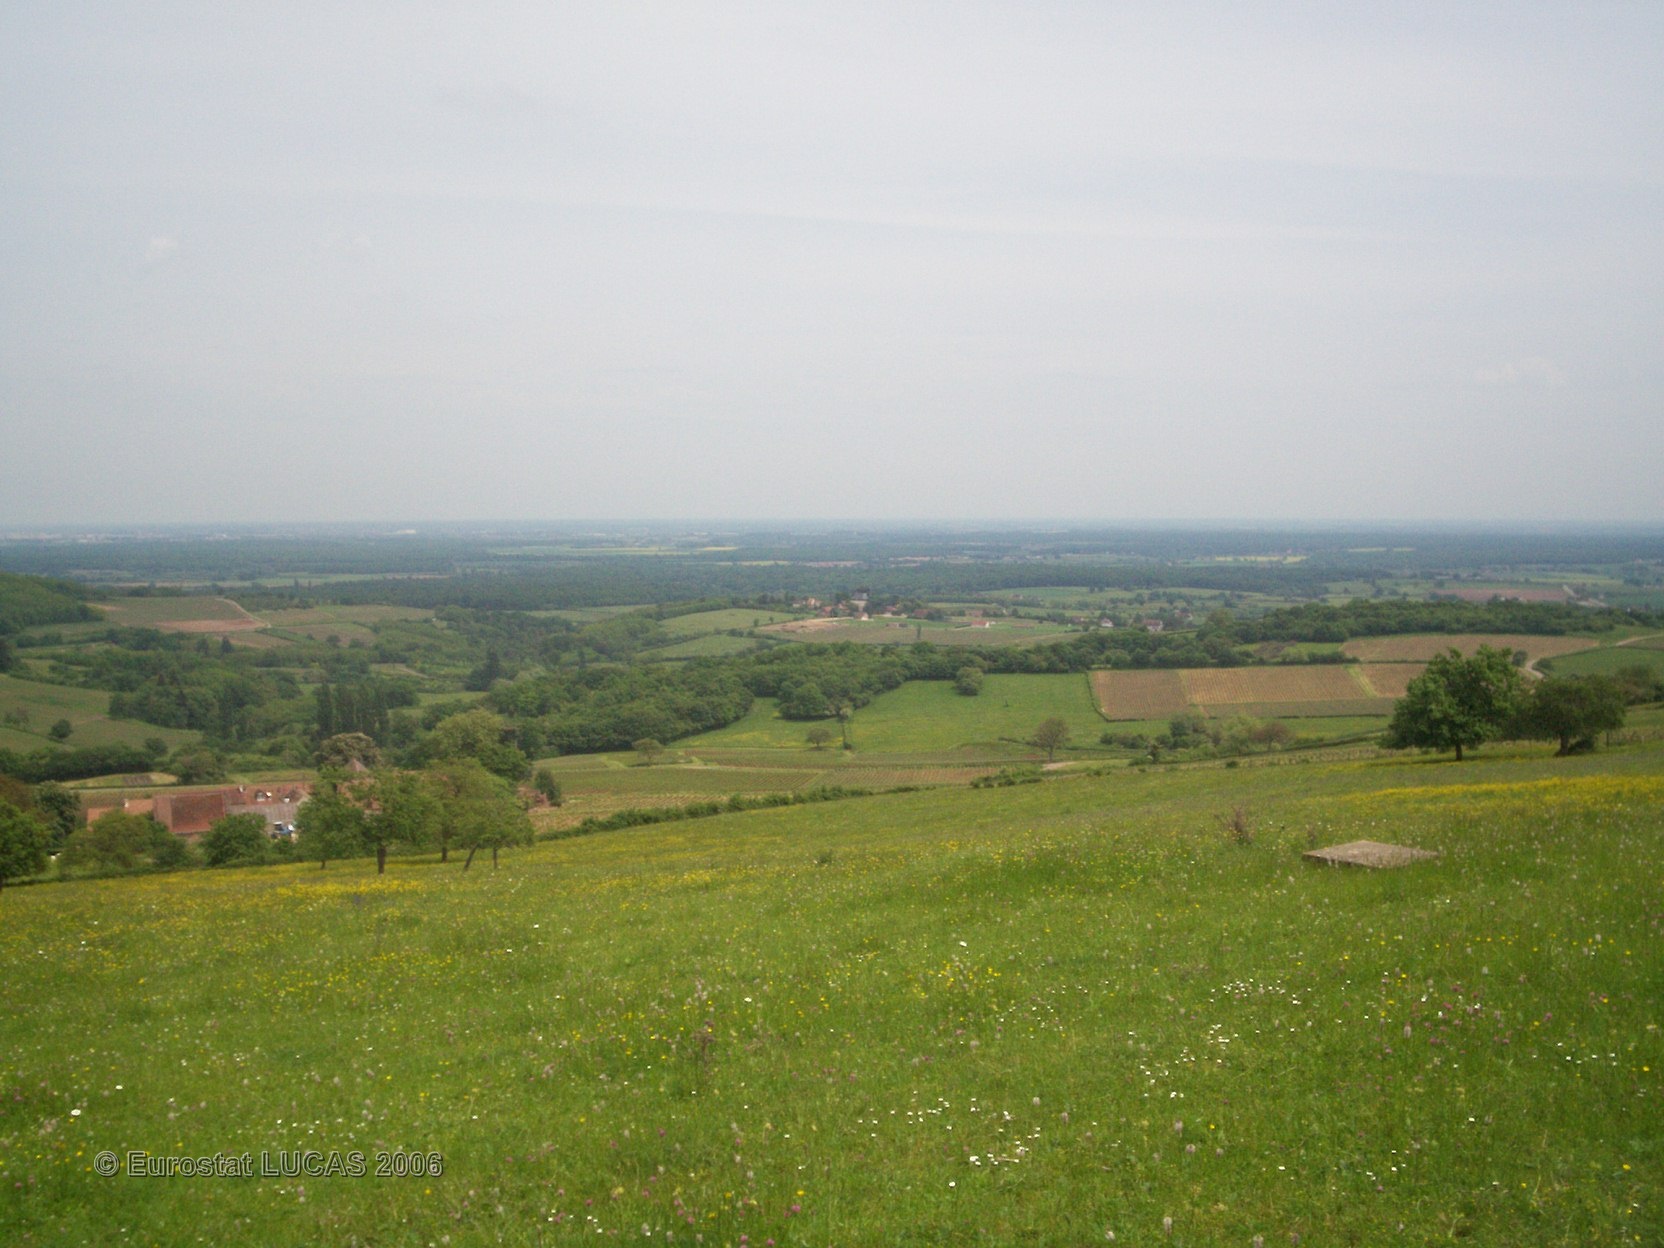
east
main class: Grassland
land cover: Grassland without tree/shrub cover
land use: Agriculture (excluding fallow land and kitchen gardens)
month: May
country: FR
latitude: 46.7240
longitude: 4.6759
